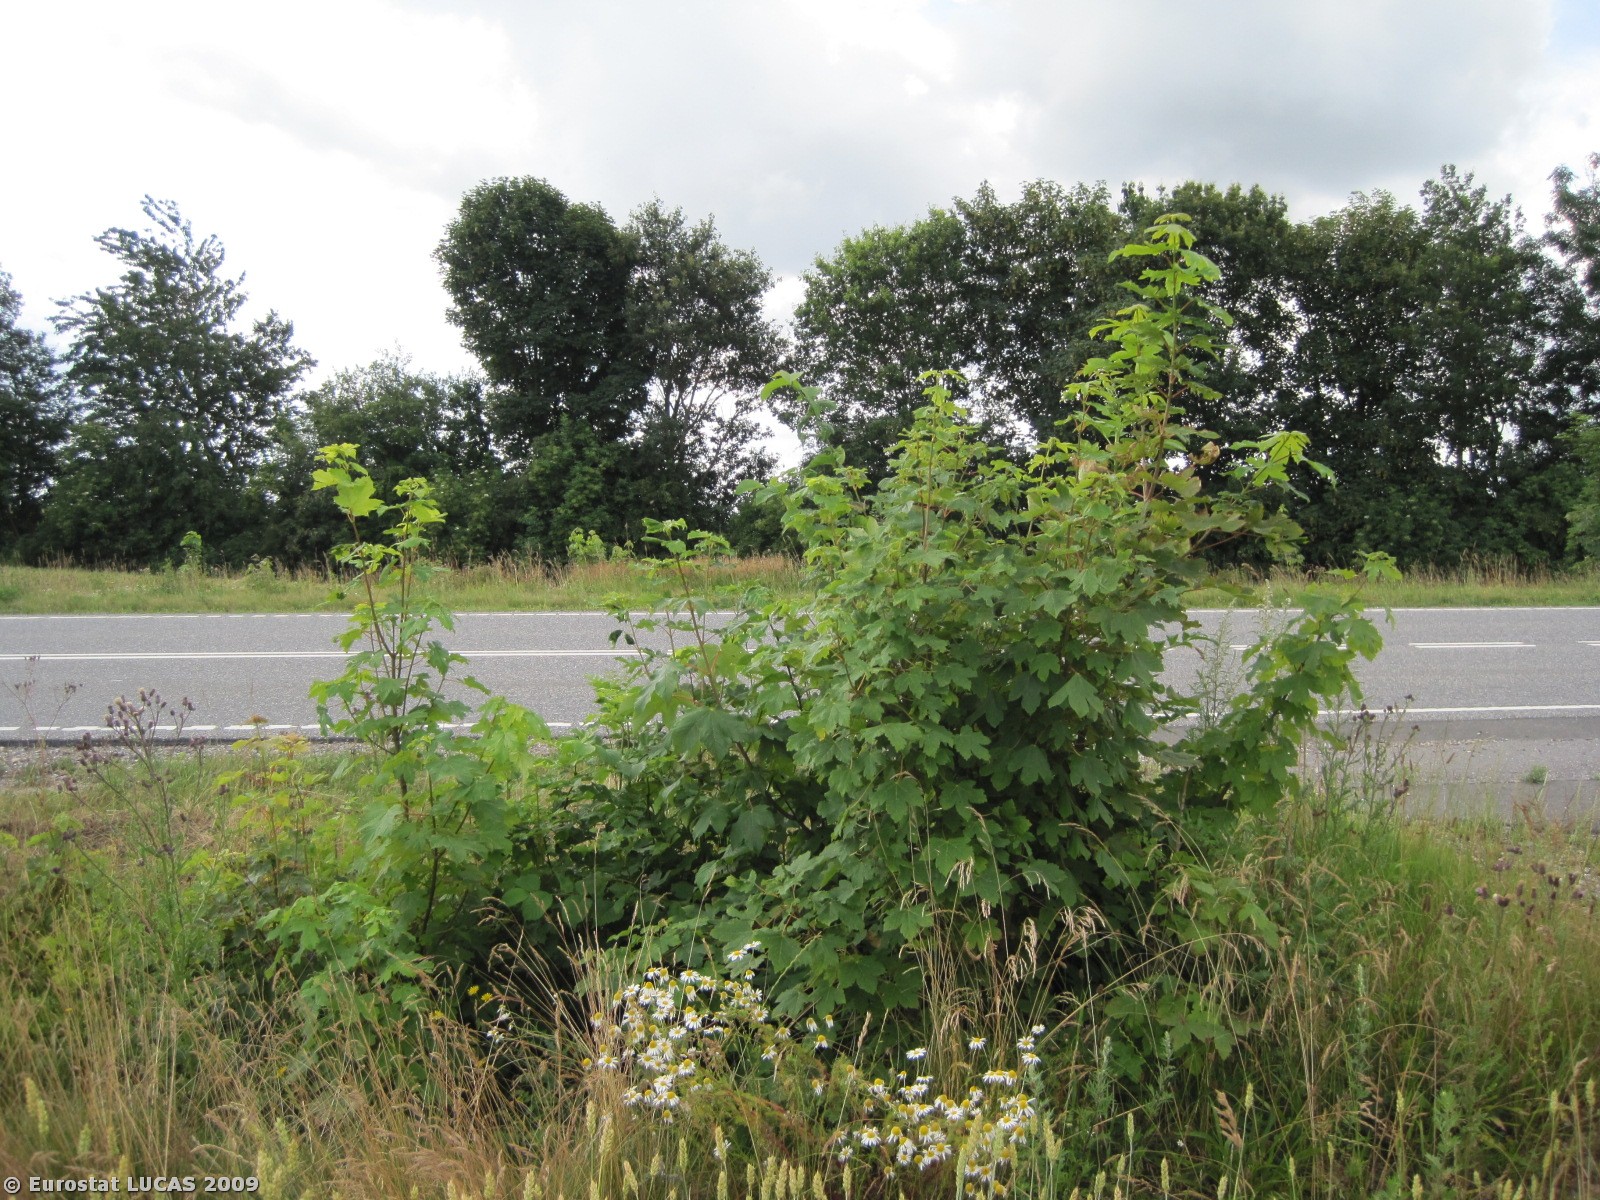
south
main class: Cropland
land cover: Common wheat
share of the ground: > 75 %
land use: Agriculture (excluding fallow land and kitchen gardens)
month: July
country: DK
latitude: 56.6727
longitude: 9.6904
